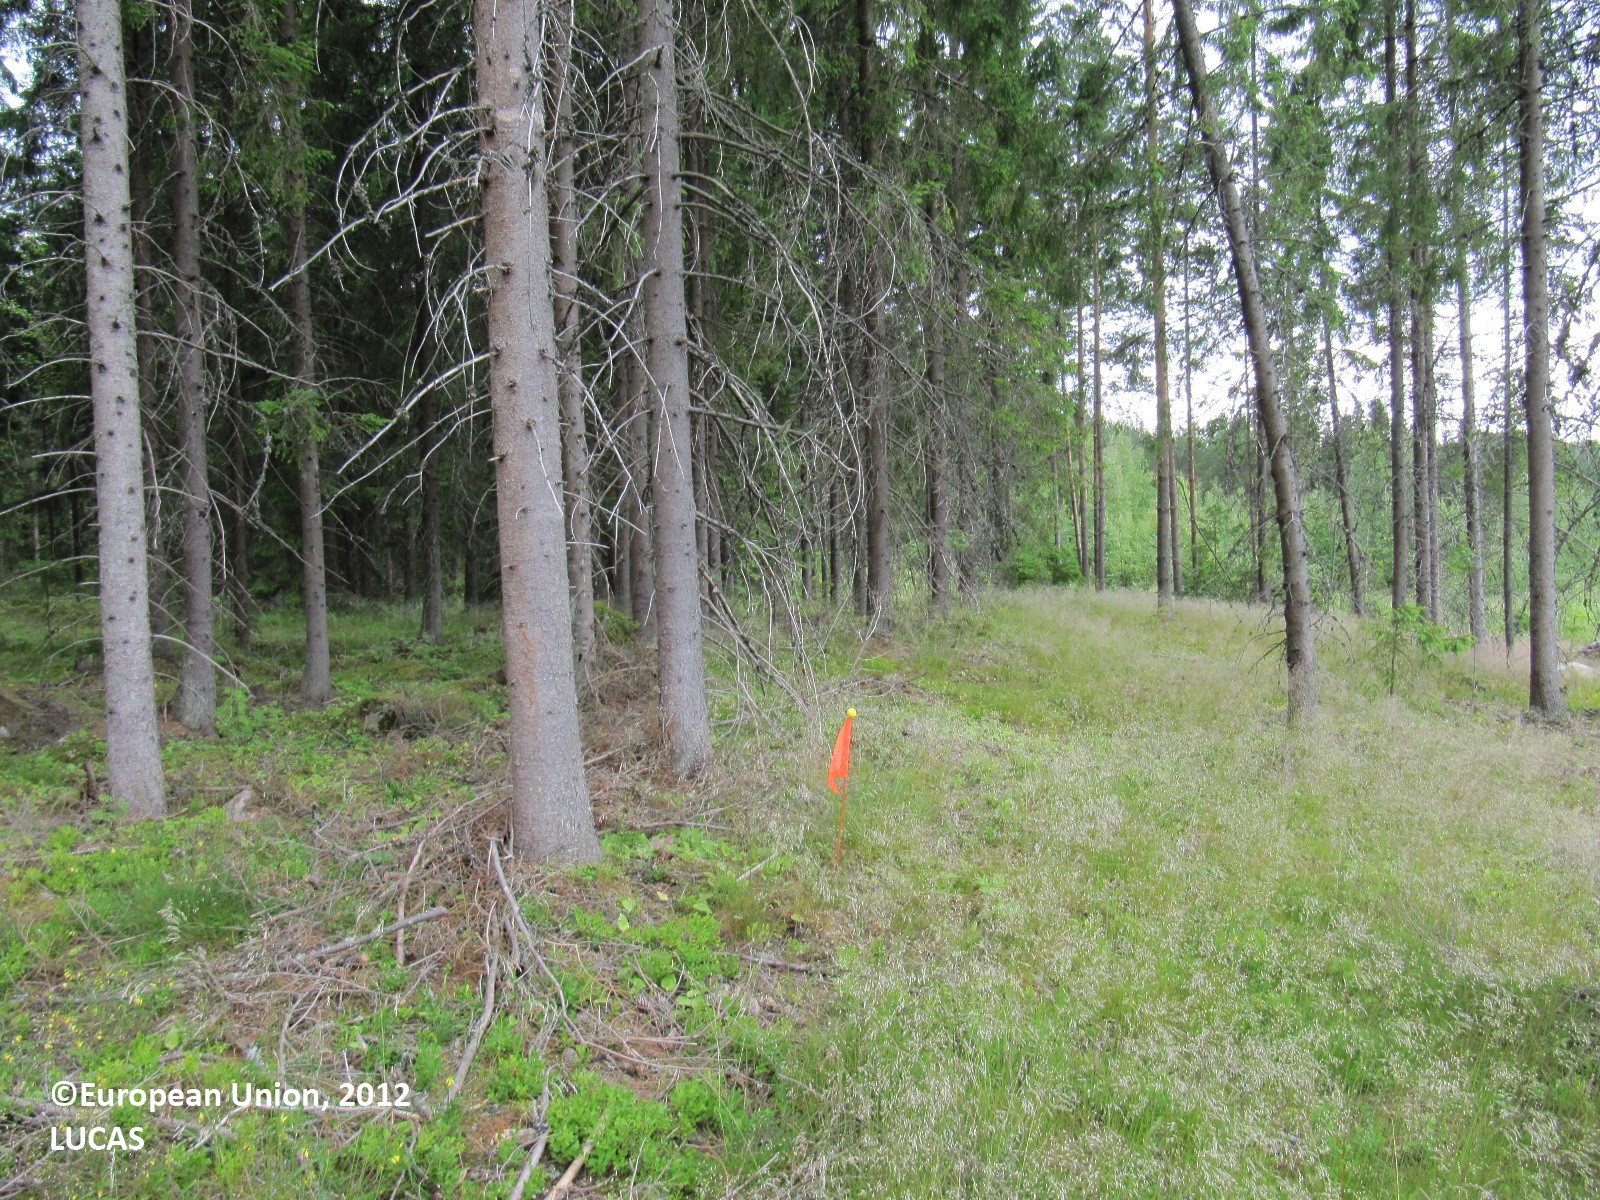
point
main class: Woodland
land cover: Spruce dominated coniferous woodland
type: boreal forest
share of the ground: > 75 %
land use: Forestry
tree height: > 5 m
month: July
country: FI
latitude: 60.9444
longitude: 23.4278
